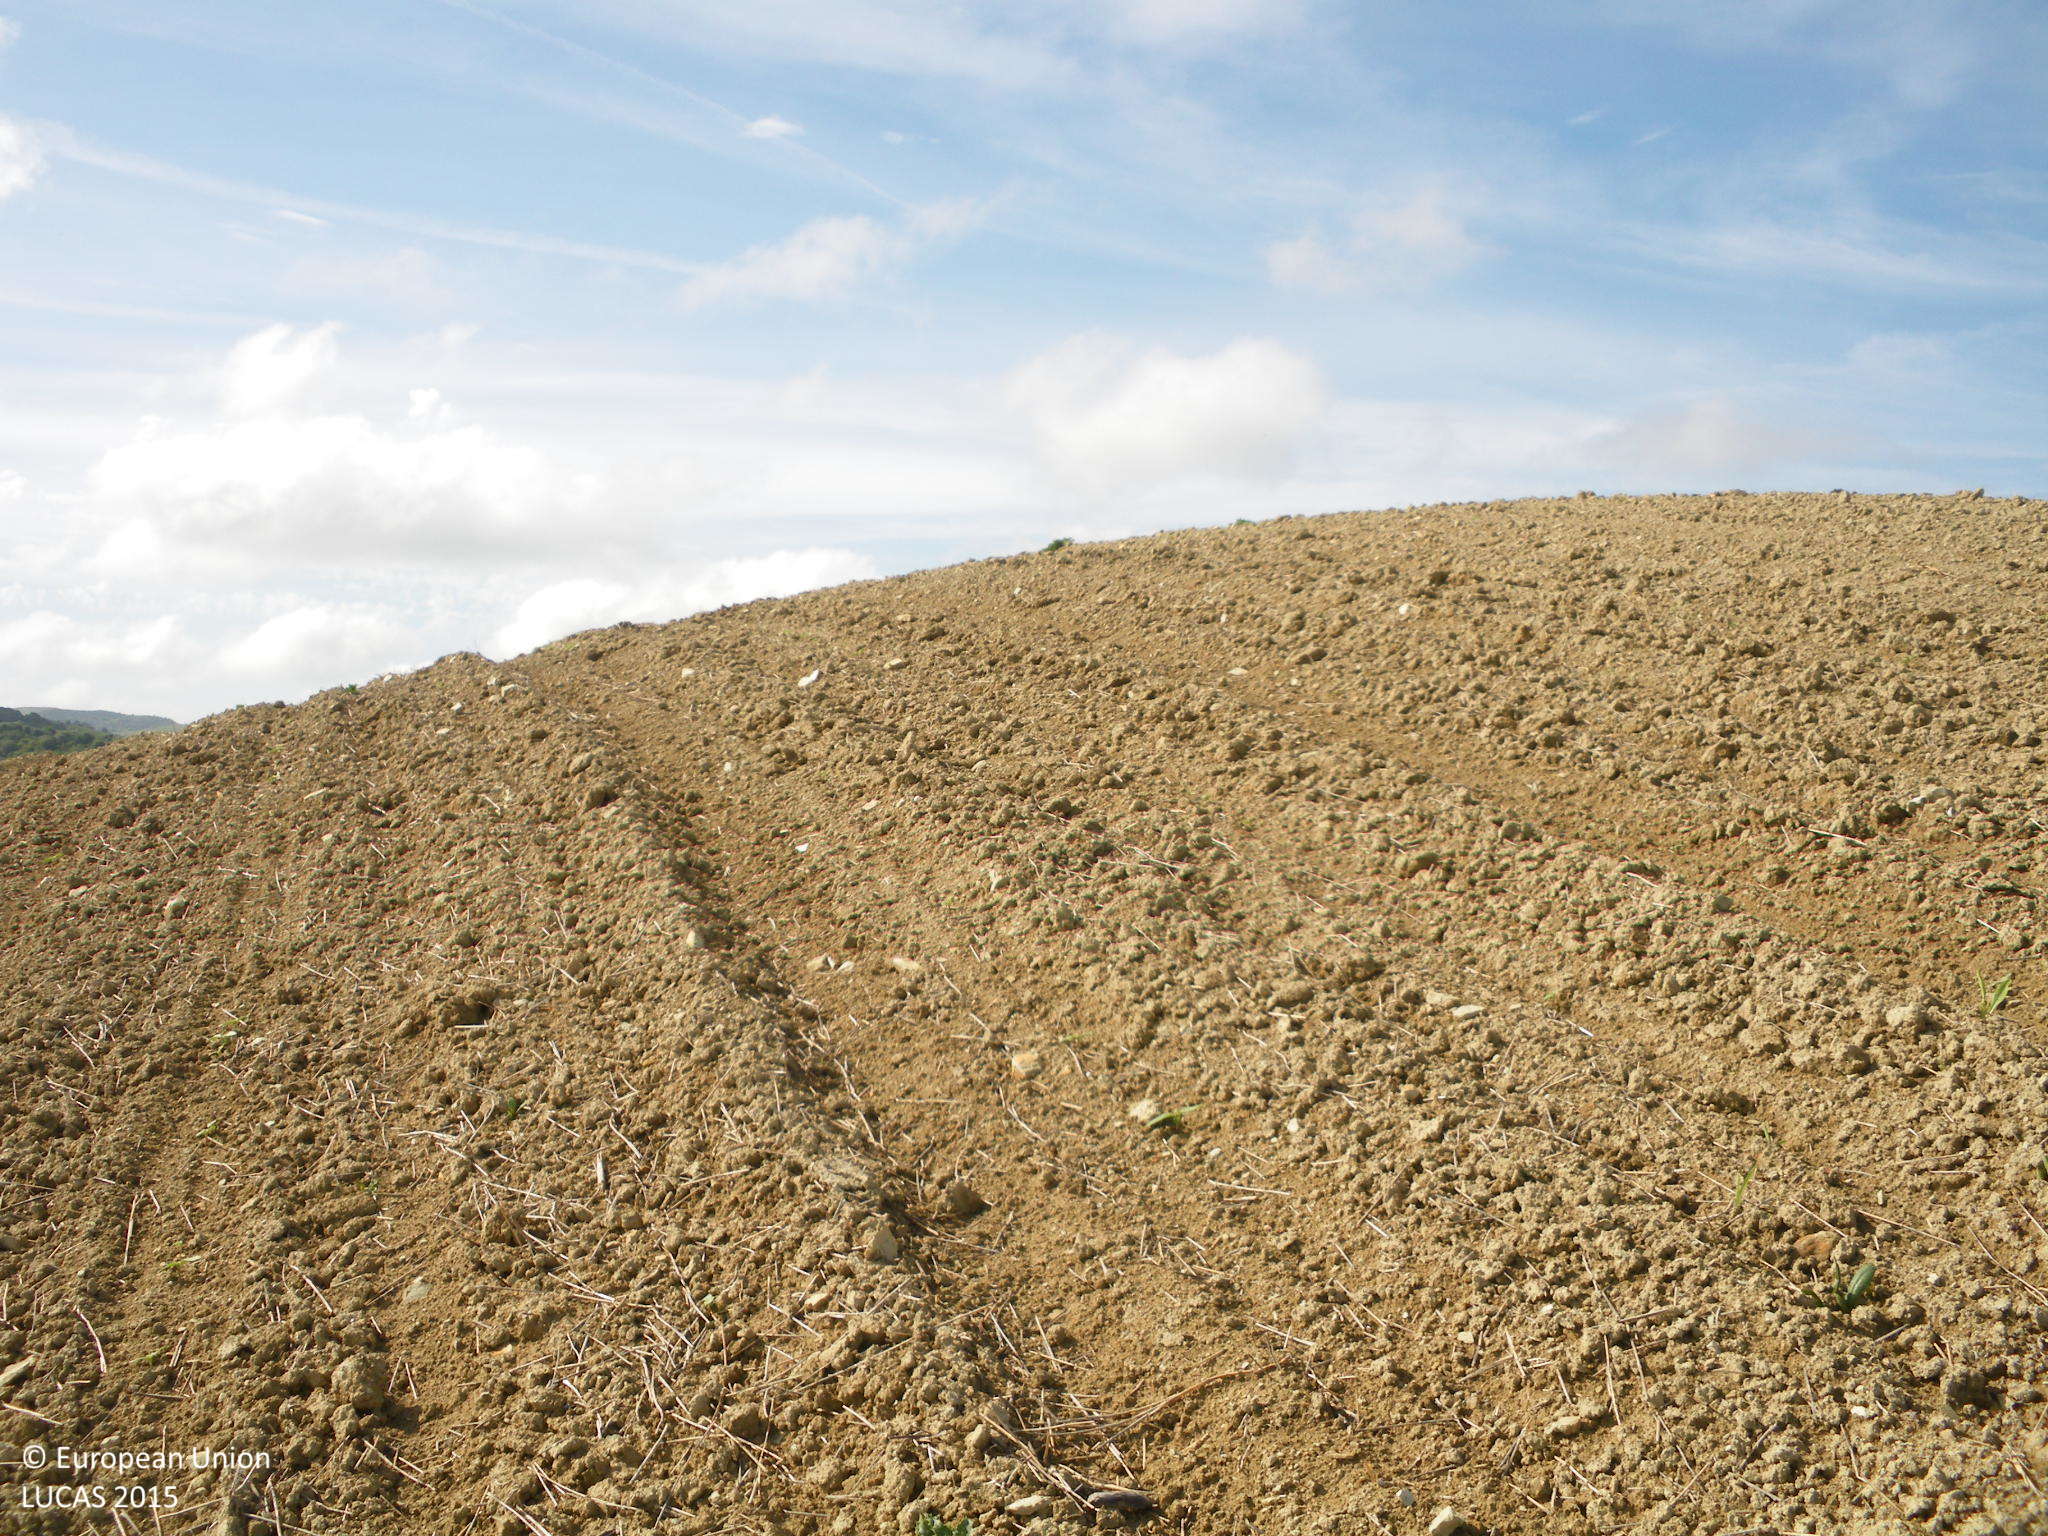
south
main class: Cropland
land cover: Sunflower
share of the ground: < 10 %
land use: Agriculture (excluding fallow land and kitchen gardens)
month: April
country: ES
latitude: 36.5476
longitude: -5.9024
